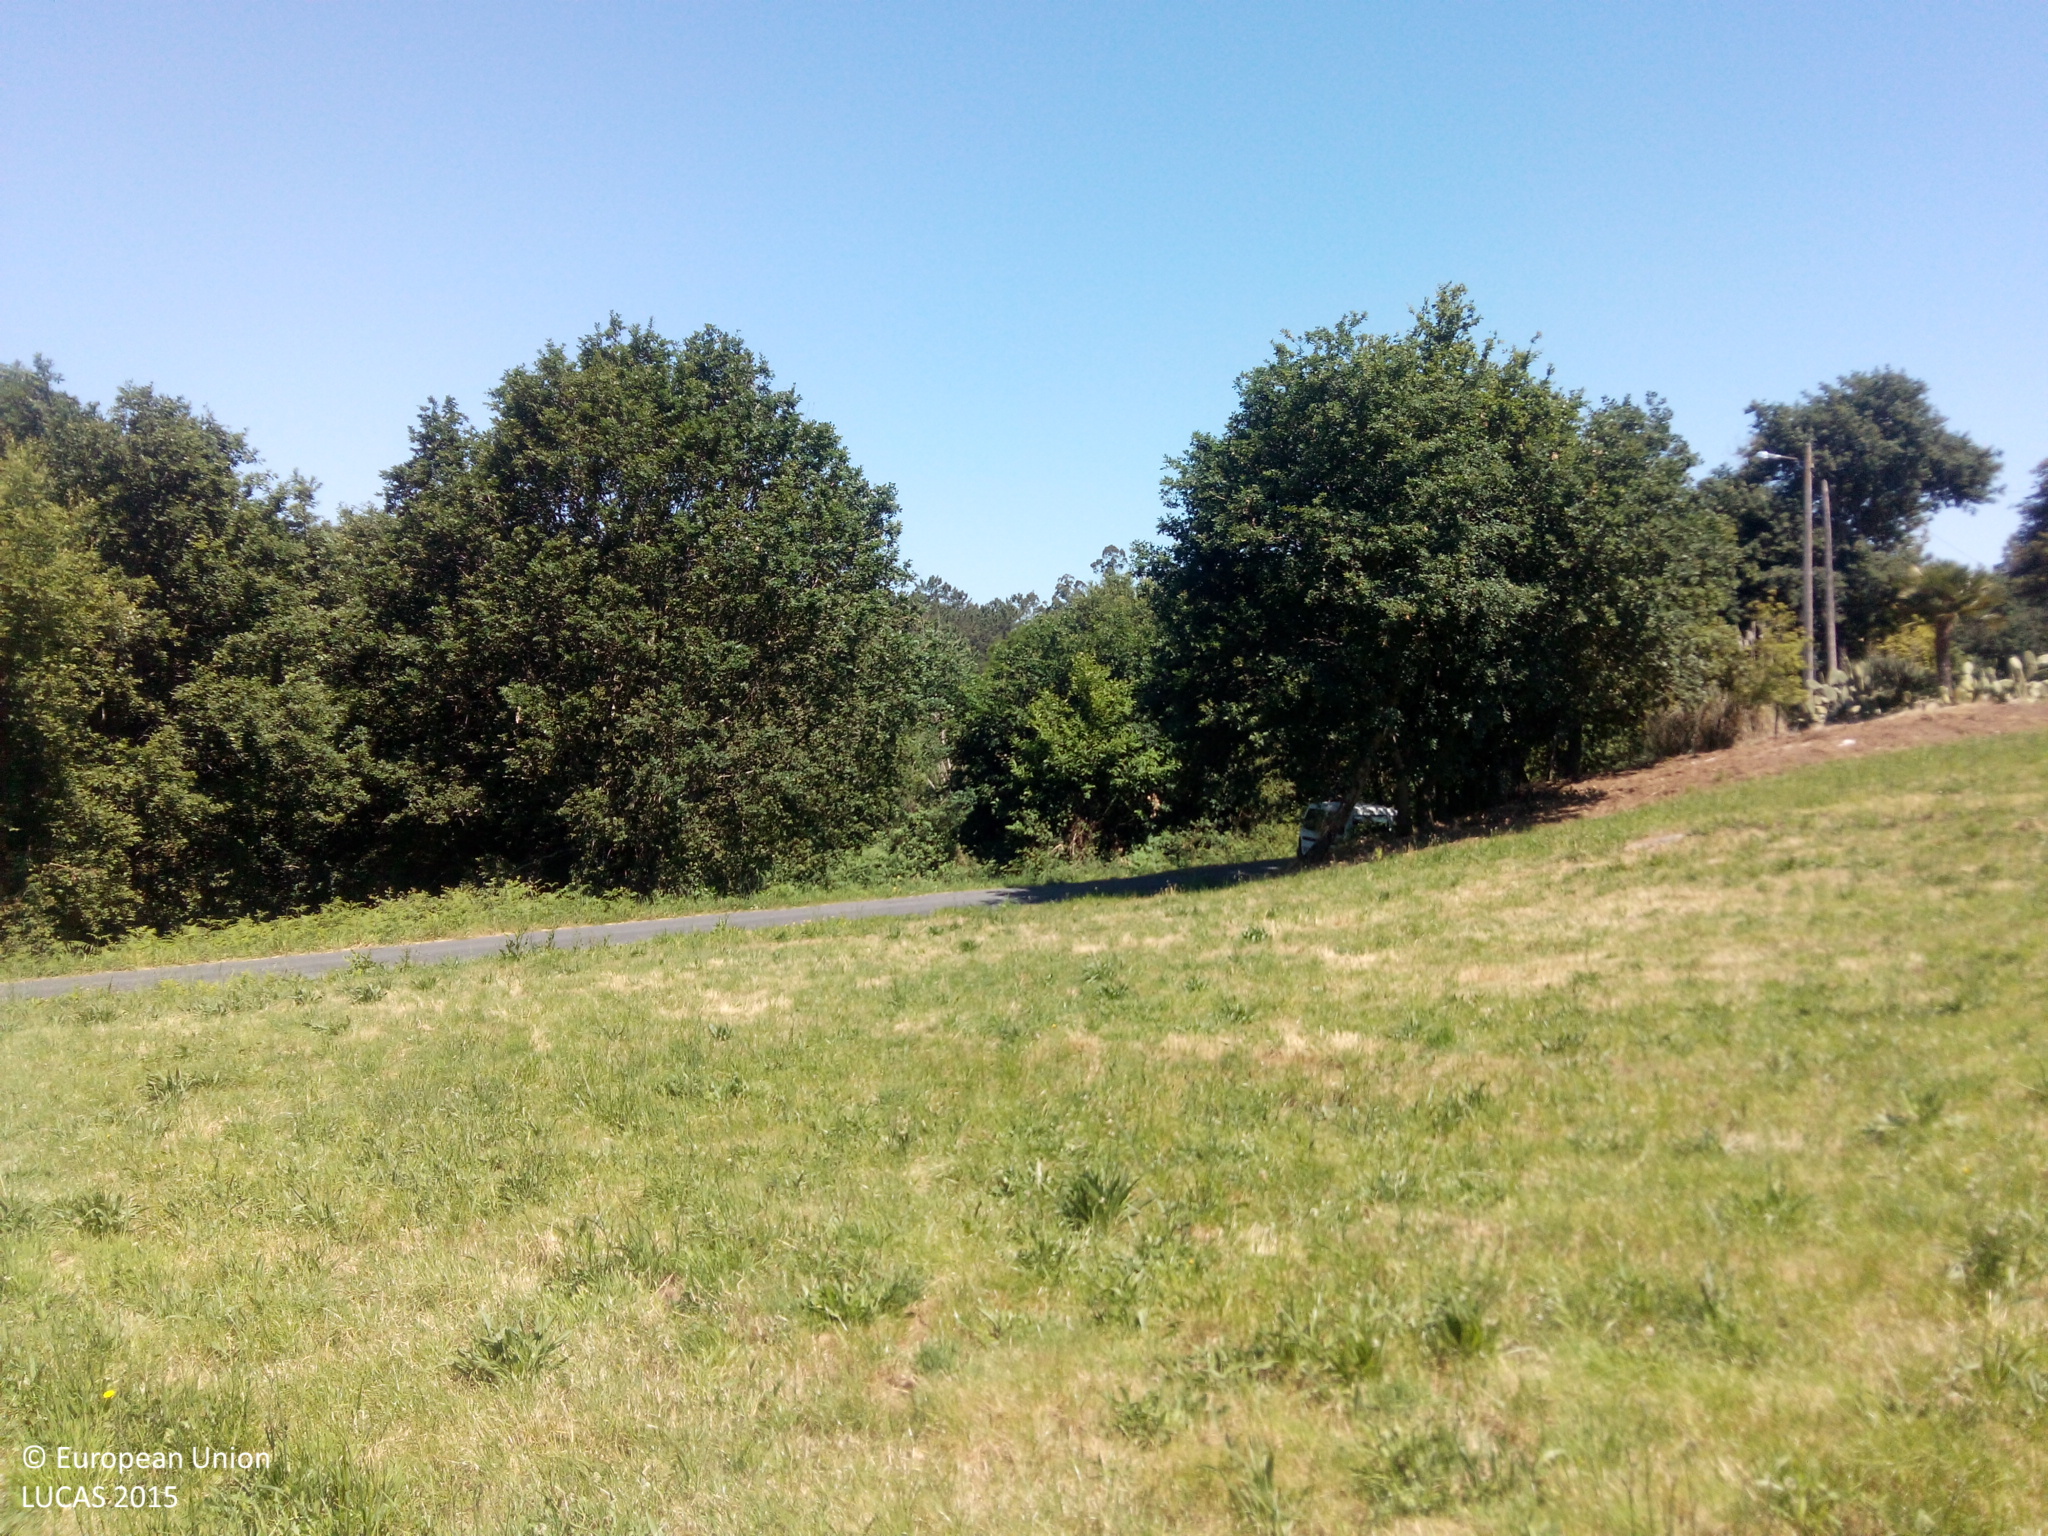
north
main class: Grassland
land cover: Grassland without tree/shrub cover
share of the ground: > 75 %
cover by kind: herbaceous plants 100 %
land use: Agriculture (excluding fallow land and kitchen gardens)
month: May
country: ES
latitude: 42.8021
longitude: -8.4797
